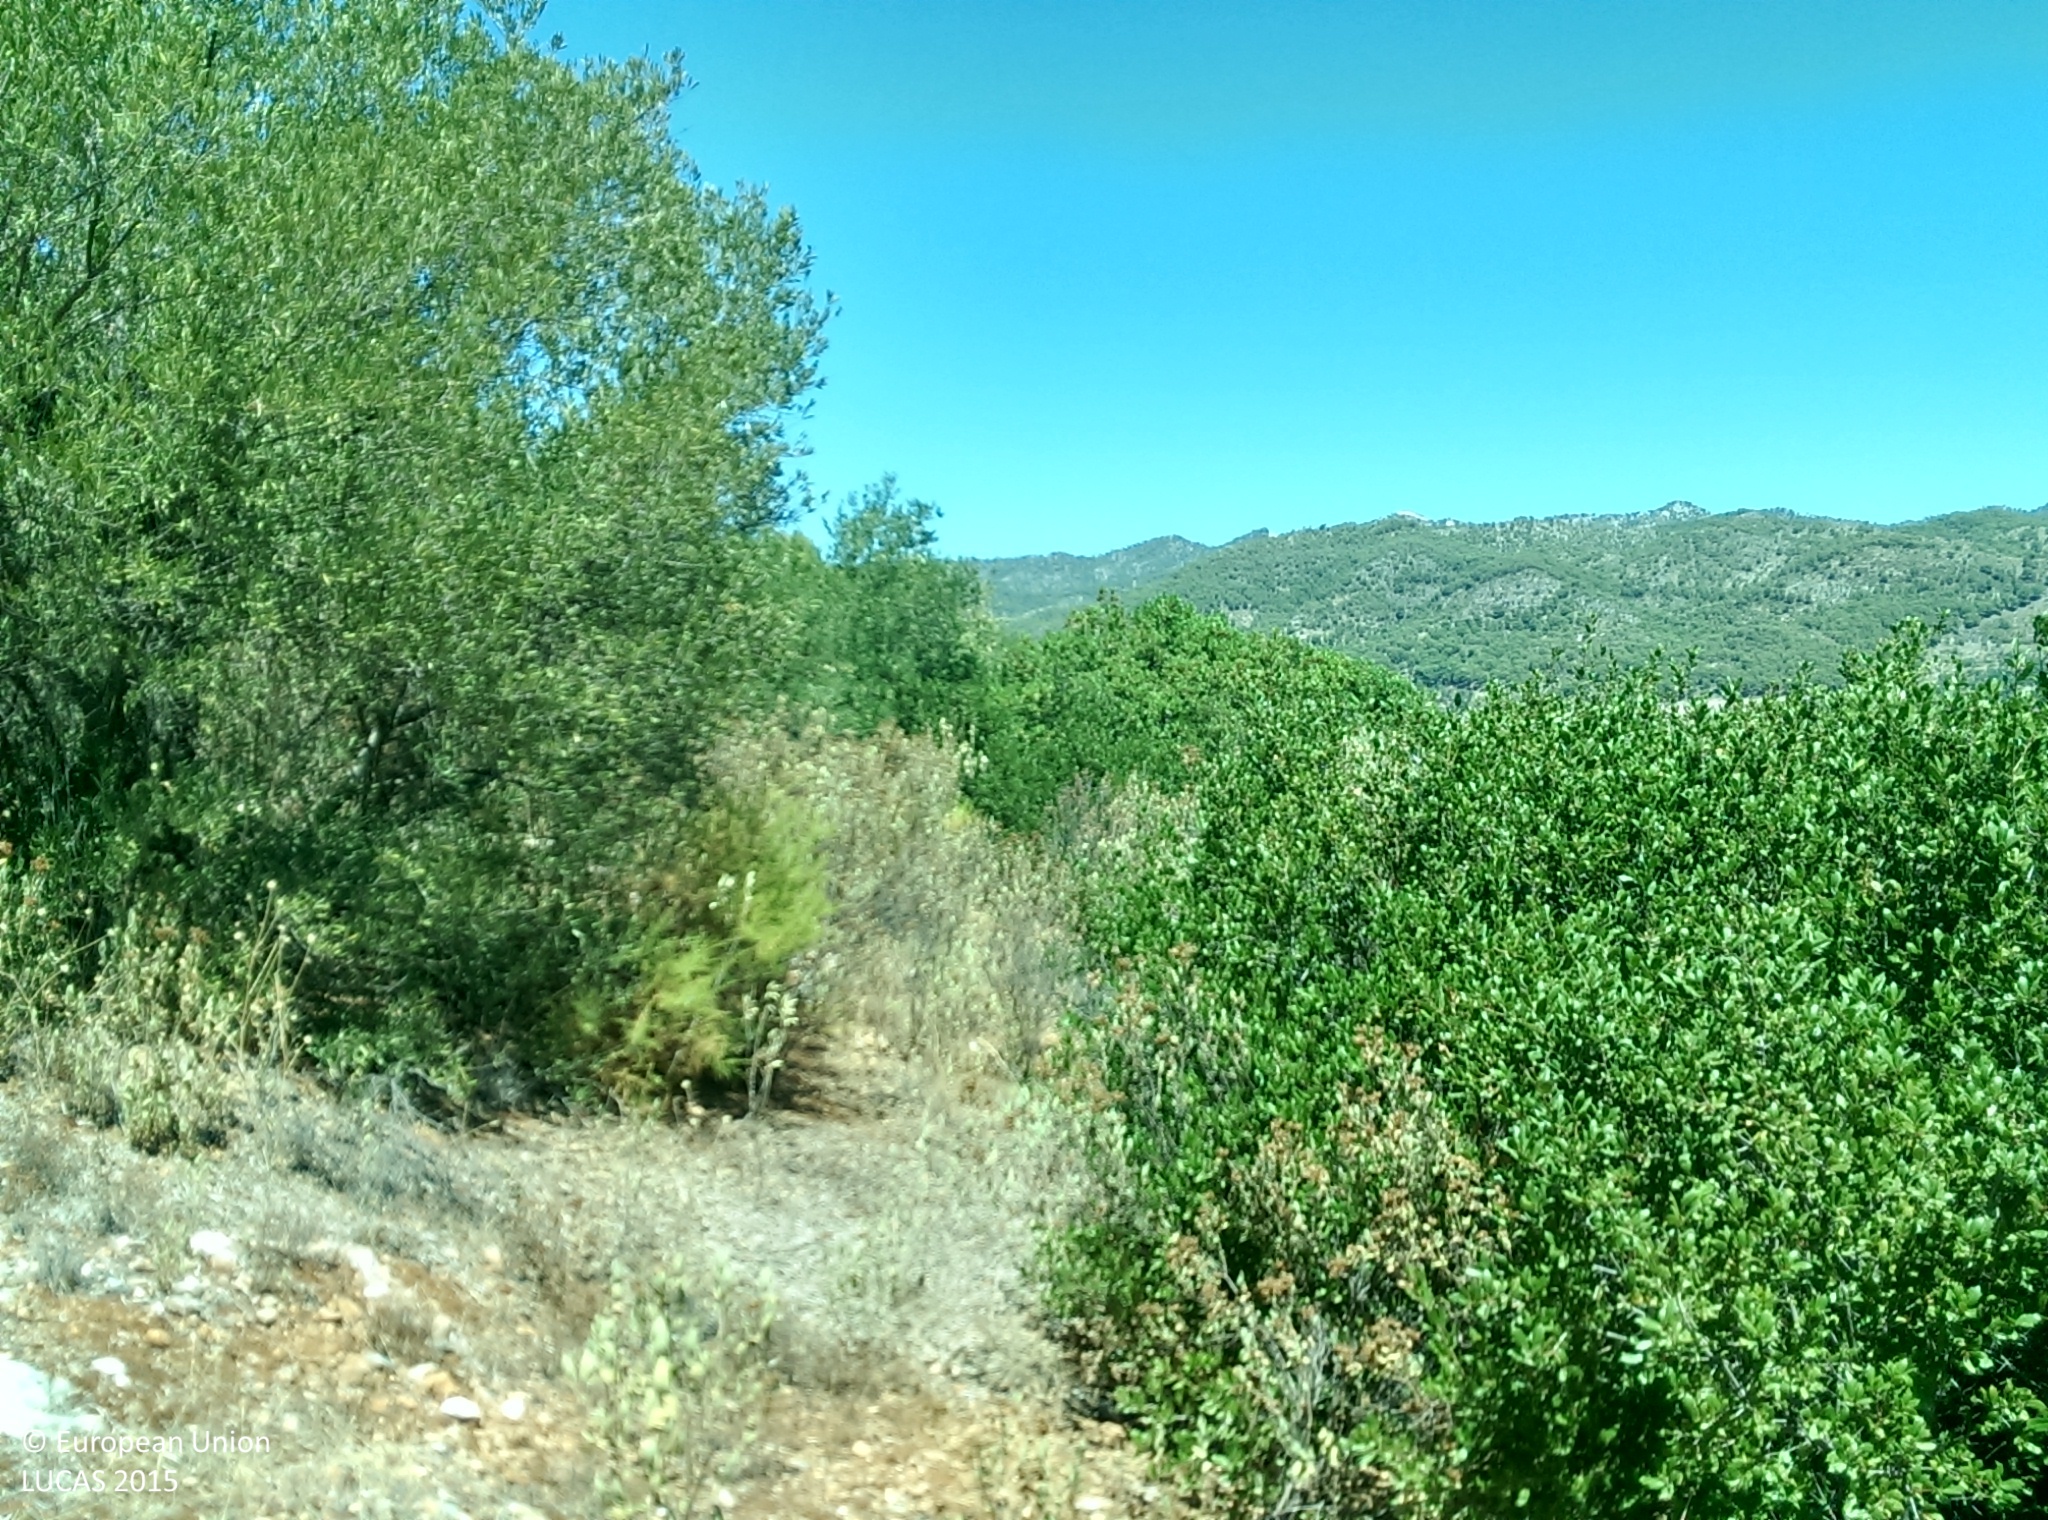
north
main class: Cropland
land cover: Olive groves
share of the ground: 25 - 50 %
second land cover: Spontaneously vegetated surfaces
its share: 10 - 25 %
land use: Abandoned areas
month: August
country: ES
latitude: 36.8525
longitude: -3.6333
